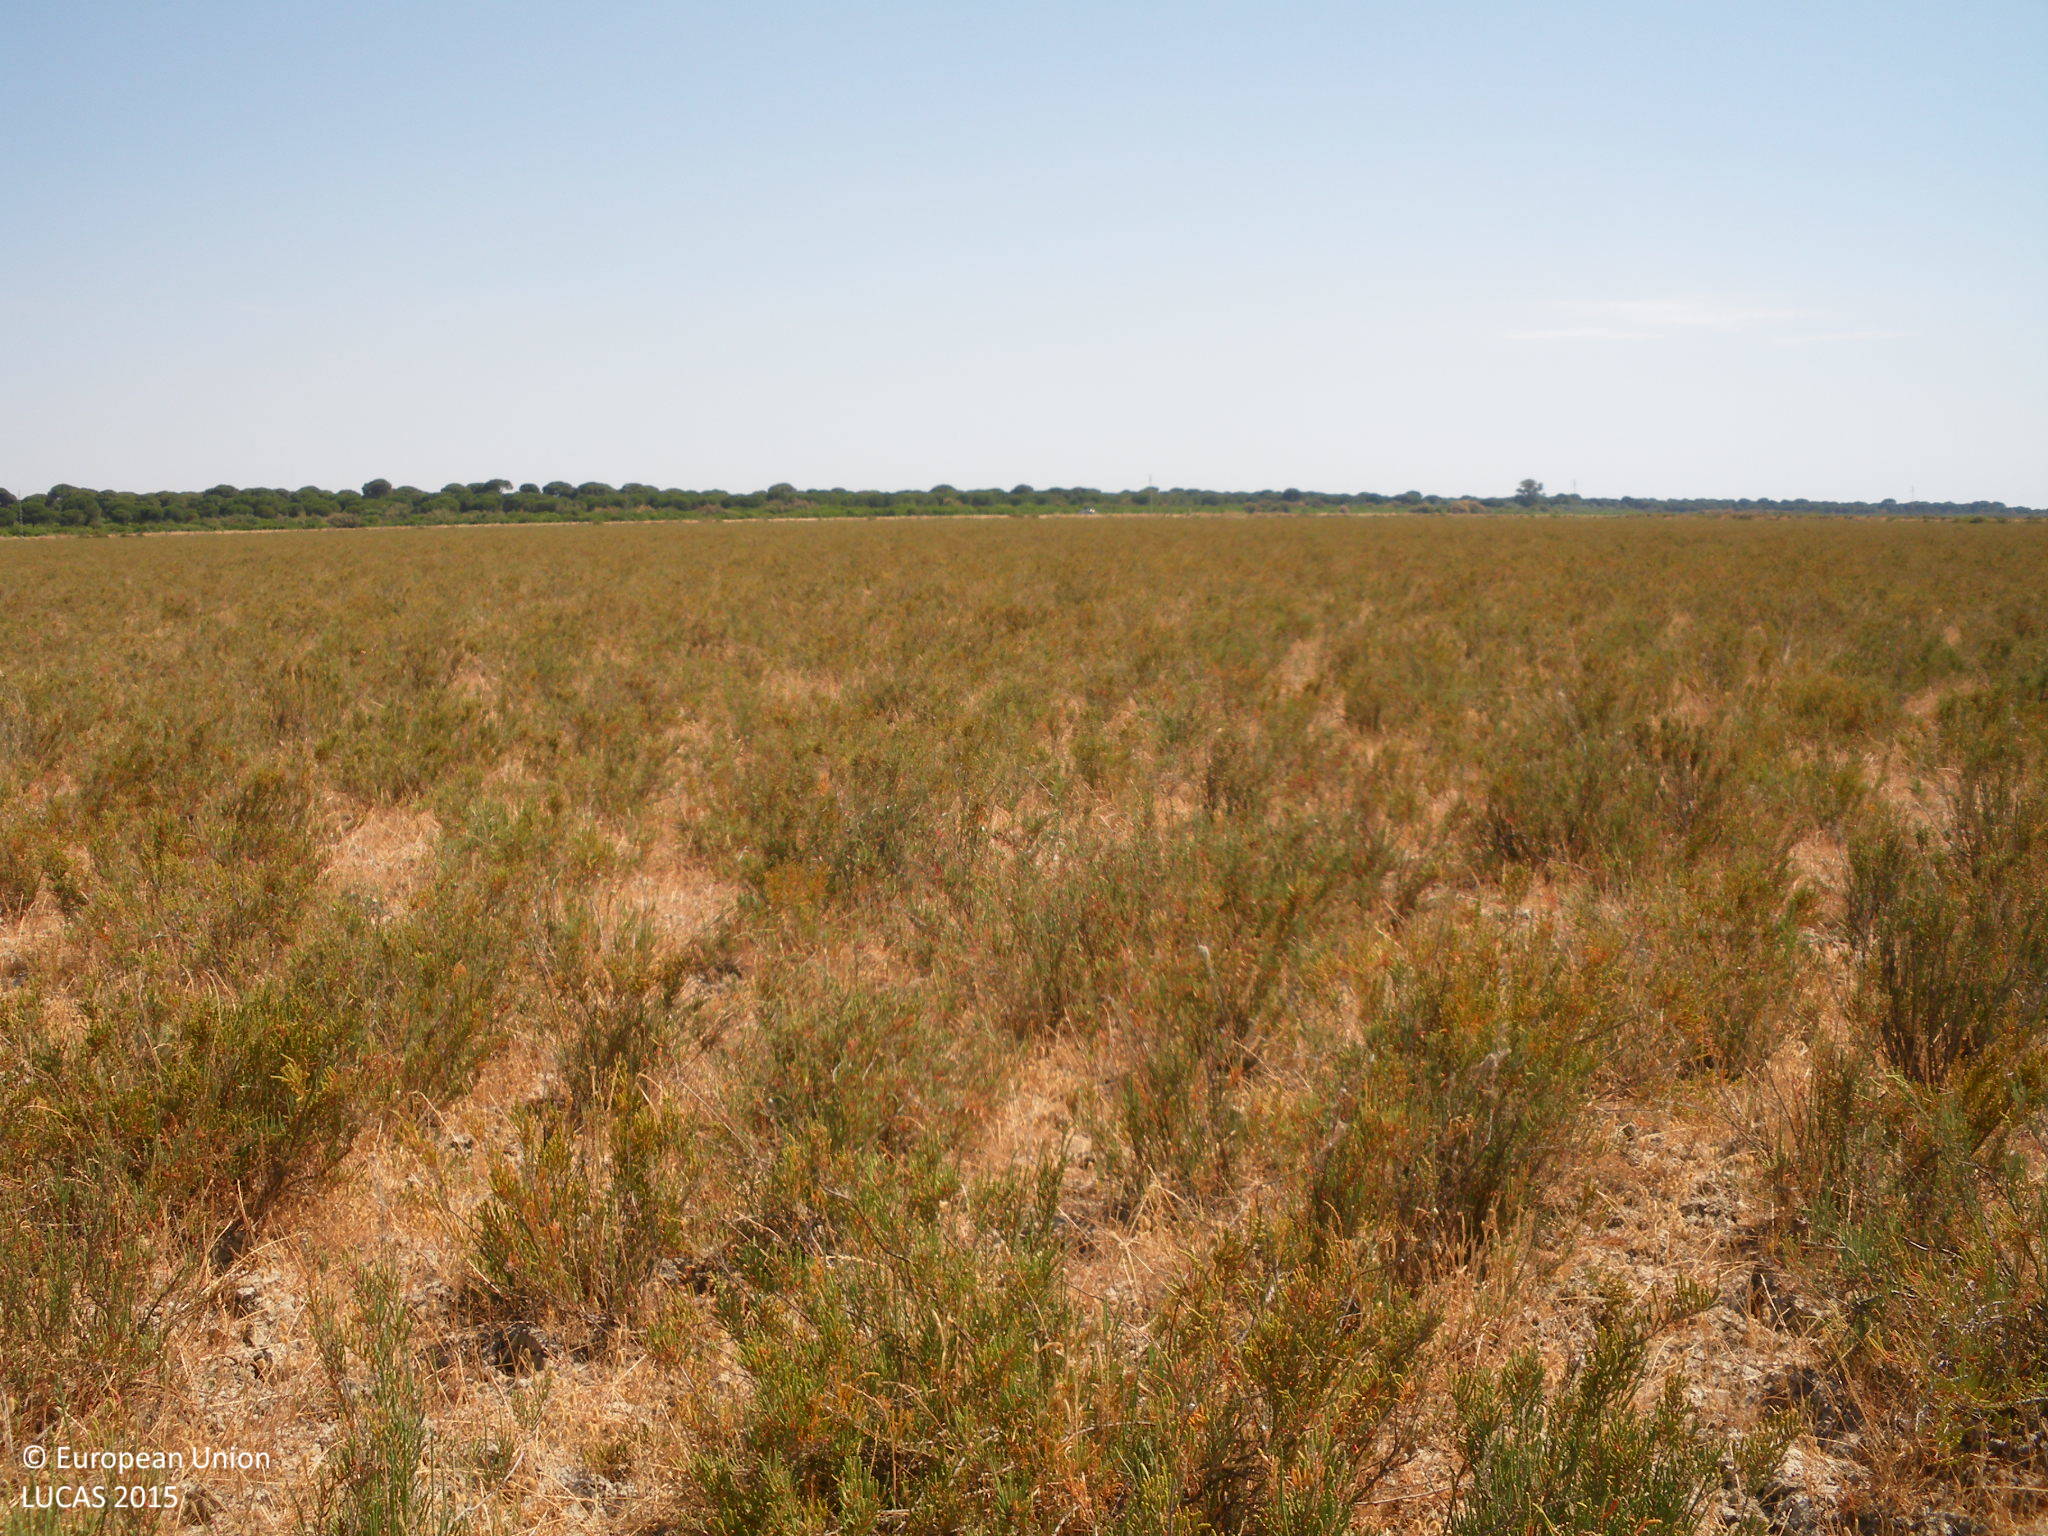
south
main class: Shrubland
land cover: Shrubland without tree cover
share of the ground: 50 - 75 %
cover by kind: shrubs 50 %, herbaceous plants 35 %, unconsolidated bare surface 15 %
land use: Agriculture (excluding fallow land and kitchen gardens)
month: May
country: ES
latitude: 36.8846
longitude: -6.2993
